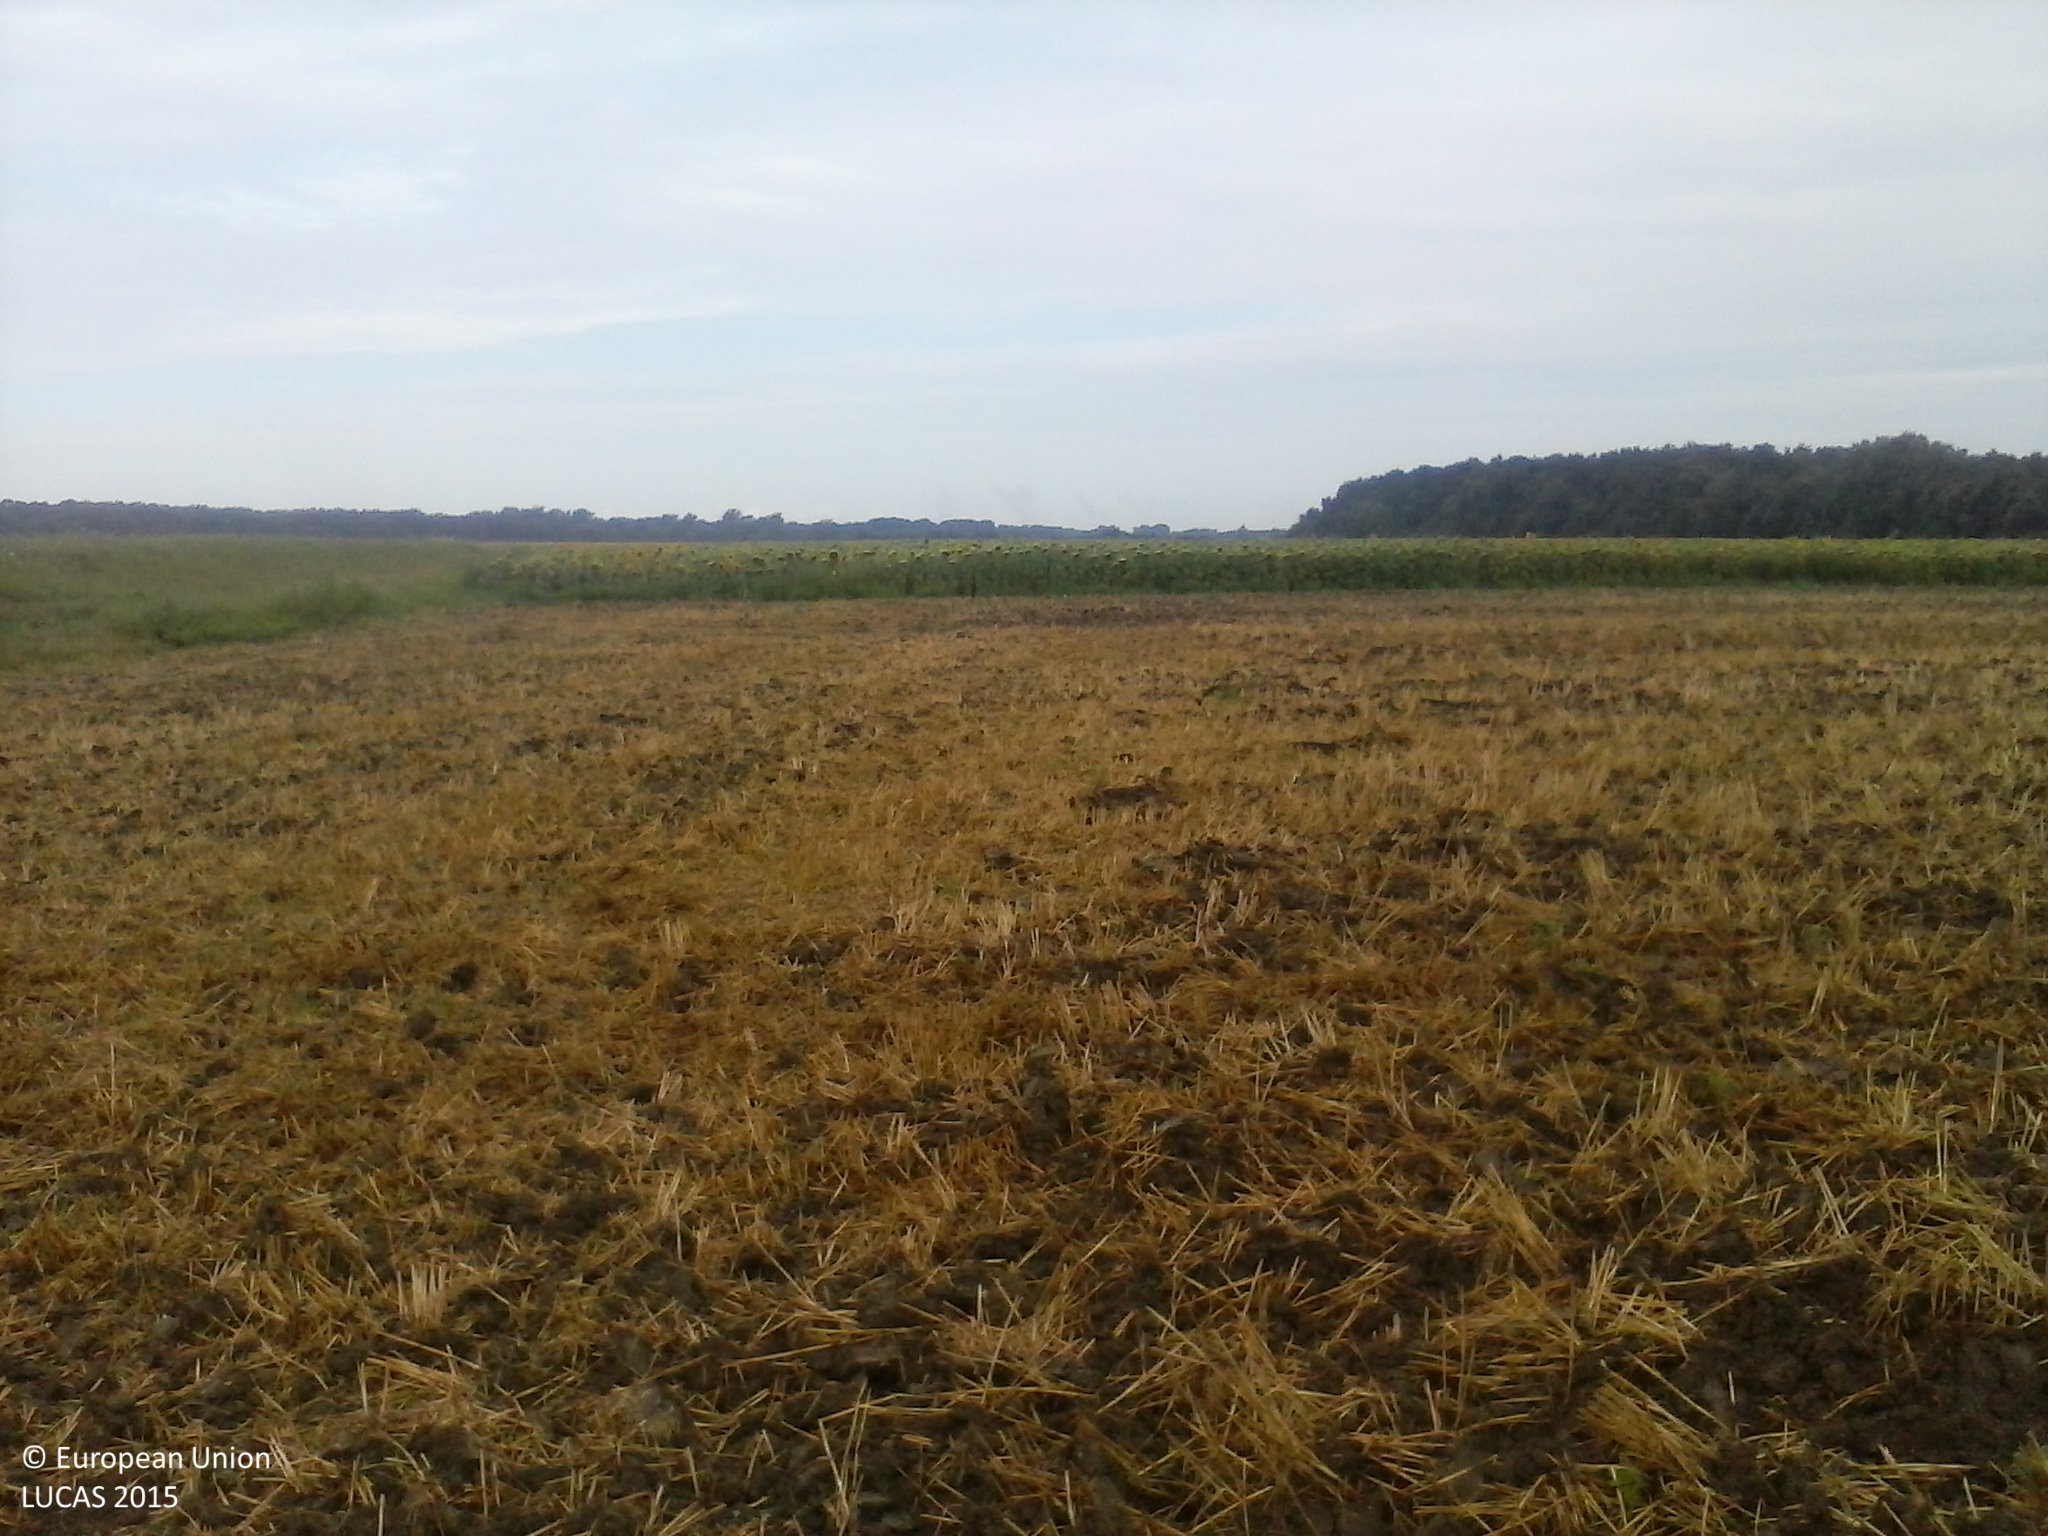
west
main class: Cropland
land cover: Common wheat
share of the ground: 50 - 75 %
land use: Agriculture (excluding fallow land and kitchen gardens)
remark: Harvested field
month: July
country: HU
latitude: 45.9161
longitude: 17.6233
